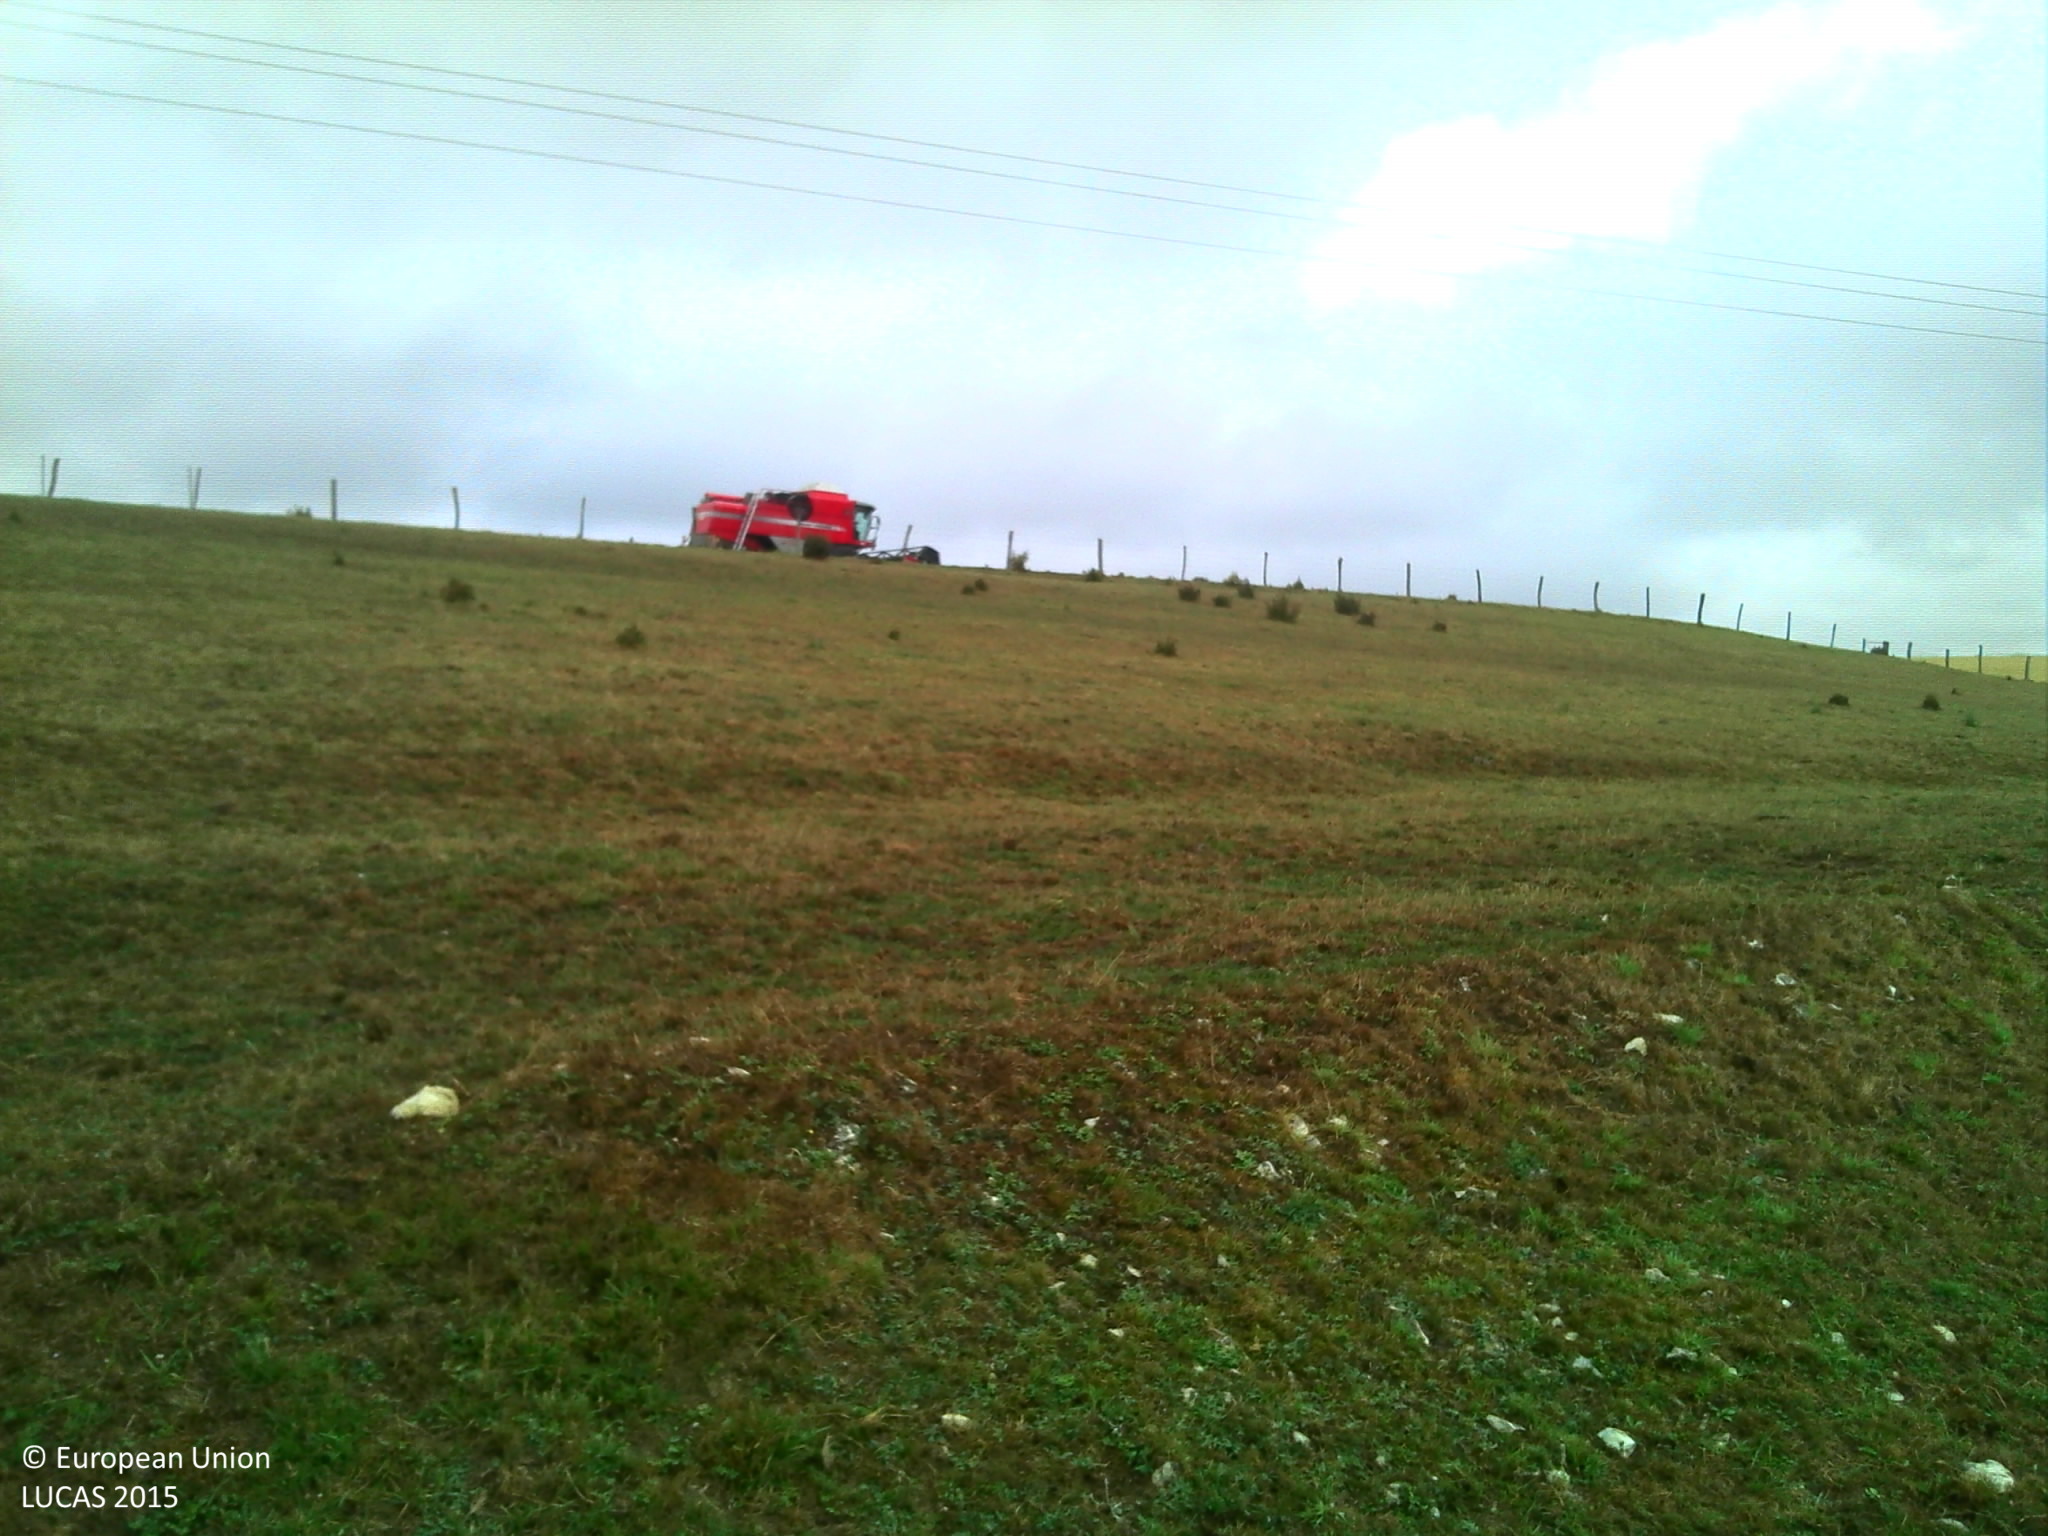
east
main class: Grassland
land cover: Grassland without tree/shrub cover
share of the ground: > 75 %
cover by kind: herbaceous plants 100 %
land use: Agriculture (excluding fallow land and kitchen gardens)
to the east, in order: Grassland without tree/shrub cover; Fences; Grassland without tree/shrub cover; Electric lines; Grassland without tree/shrub cover; Fences; Rye
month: July
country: FR
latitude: 49.1757
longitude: 5.0459
